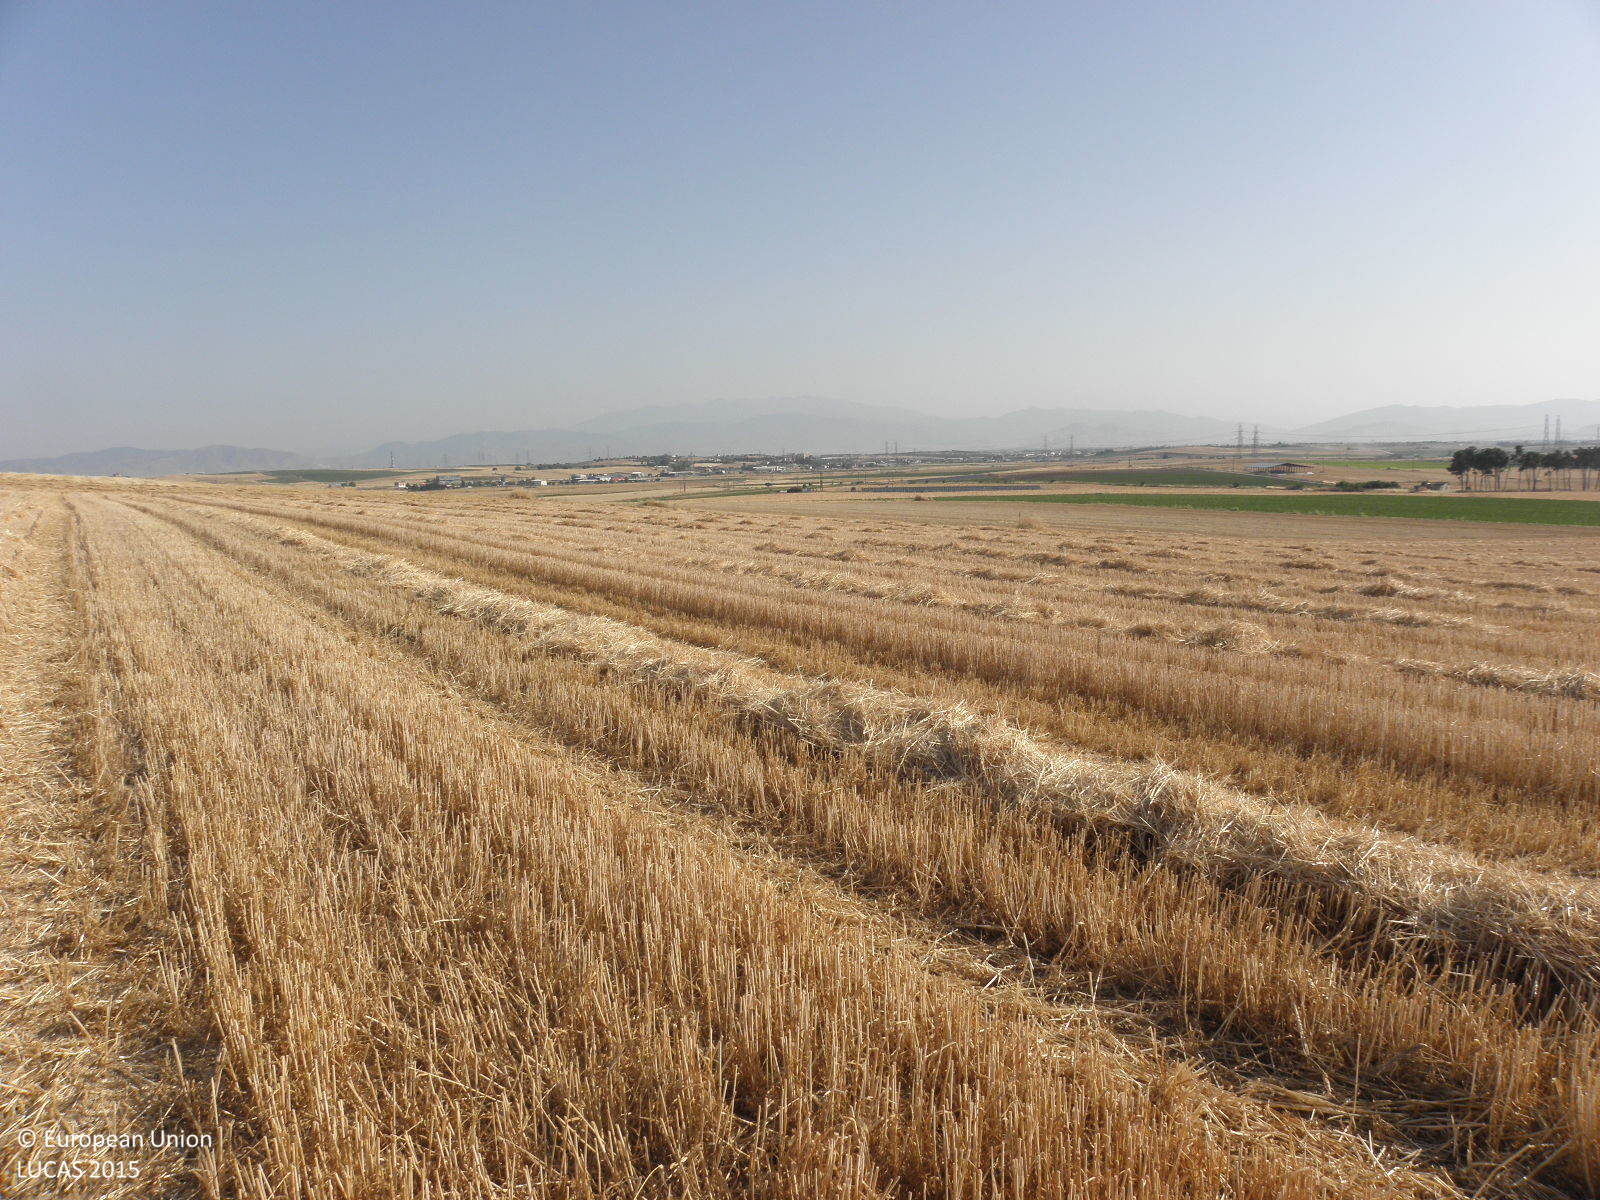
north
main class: Cropland
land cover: Durum wheat
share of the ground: > 75 %
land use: Agriculture (excluding fallow land and kitchen gardens)
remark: Harvested field
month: June
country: GR
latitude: 39.5706
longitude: 22.3861
